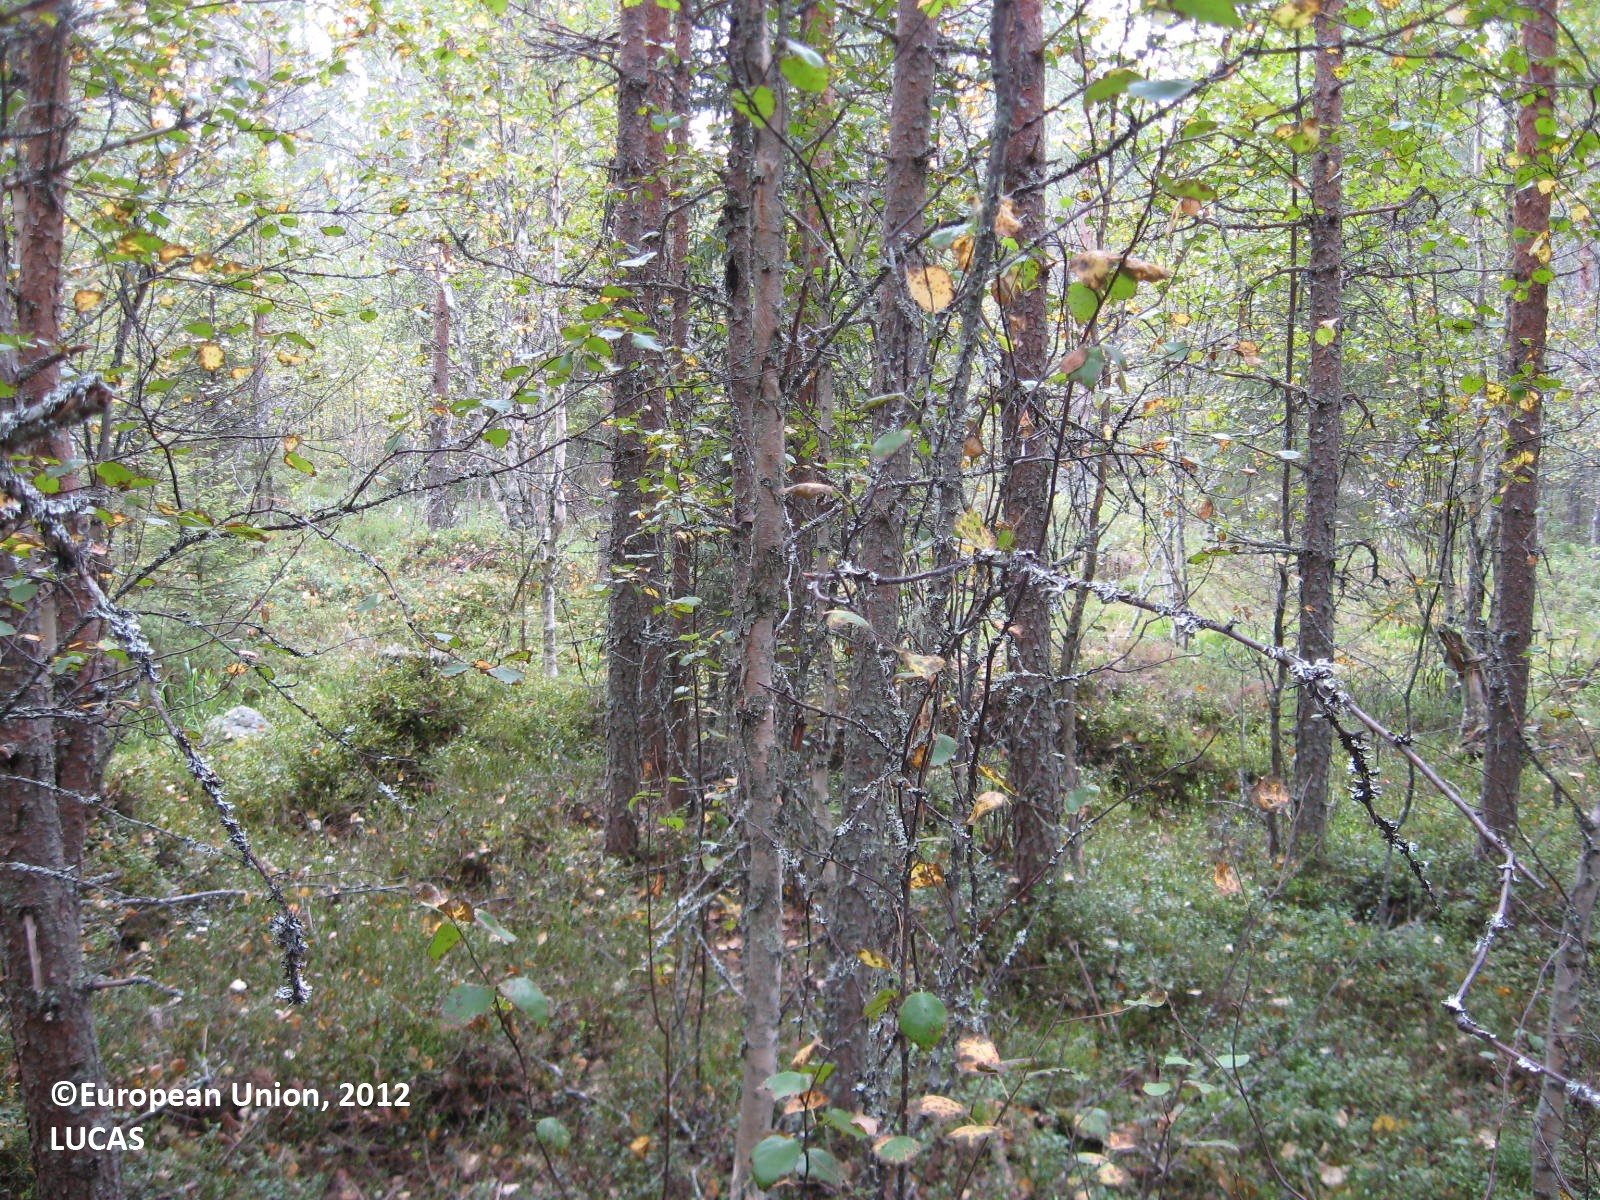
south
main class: Woodland
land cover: Pine dominated mixed woodland
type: boreal forest
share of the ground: > 75 %
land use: Forestry
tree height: > 5 m
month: August
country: FI
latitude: 63.5467
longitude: 30.3215
